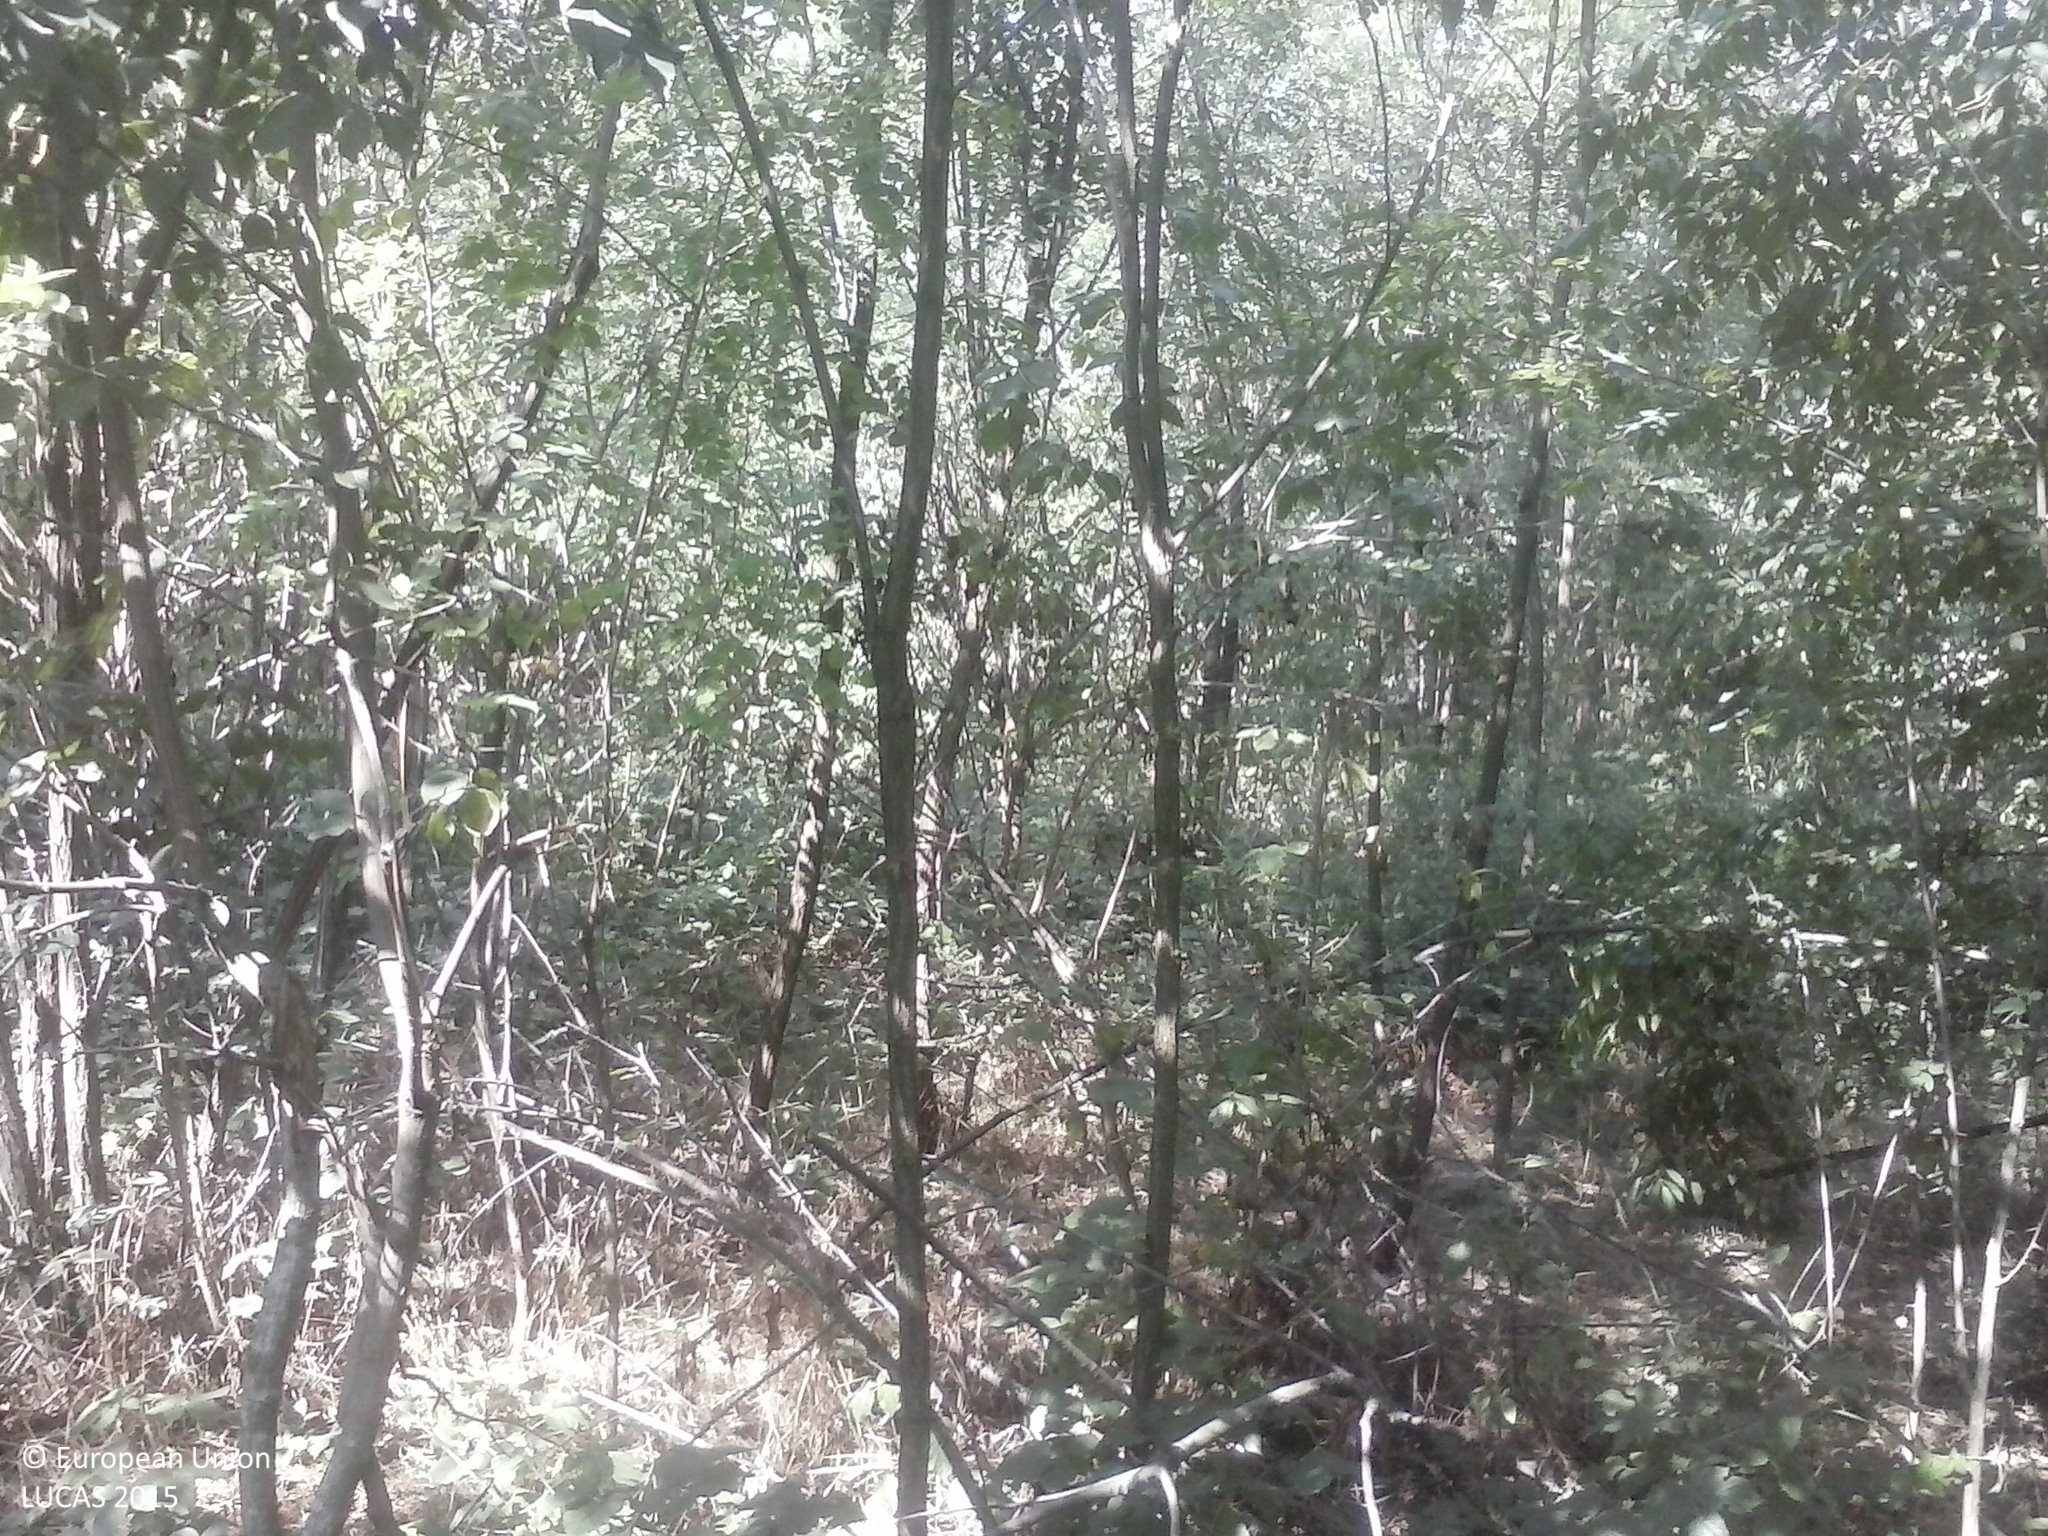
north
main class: Shrubland
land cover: Shrubland with sparse tree cover
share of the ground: > 75 %
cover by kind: shrubs 90 %, broadleaved forest trees 5 %, herbaceous plants 5 %
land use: Abandoned areas
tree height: < 5 m
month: August
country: HU
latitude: 46.0020
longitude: 17.6873
